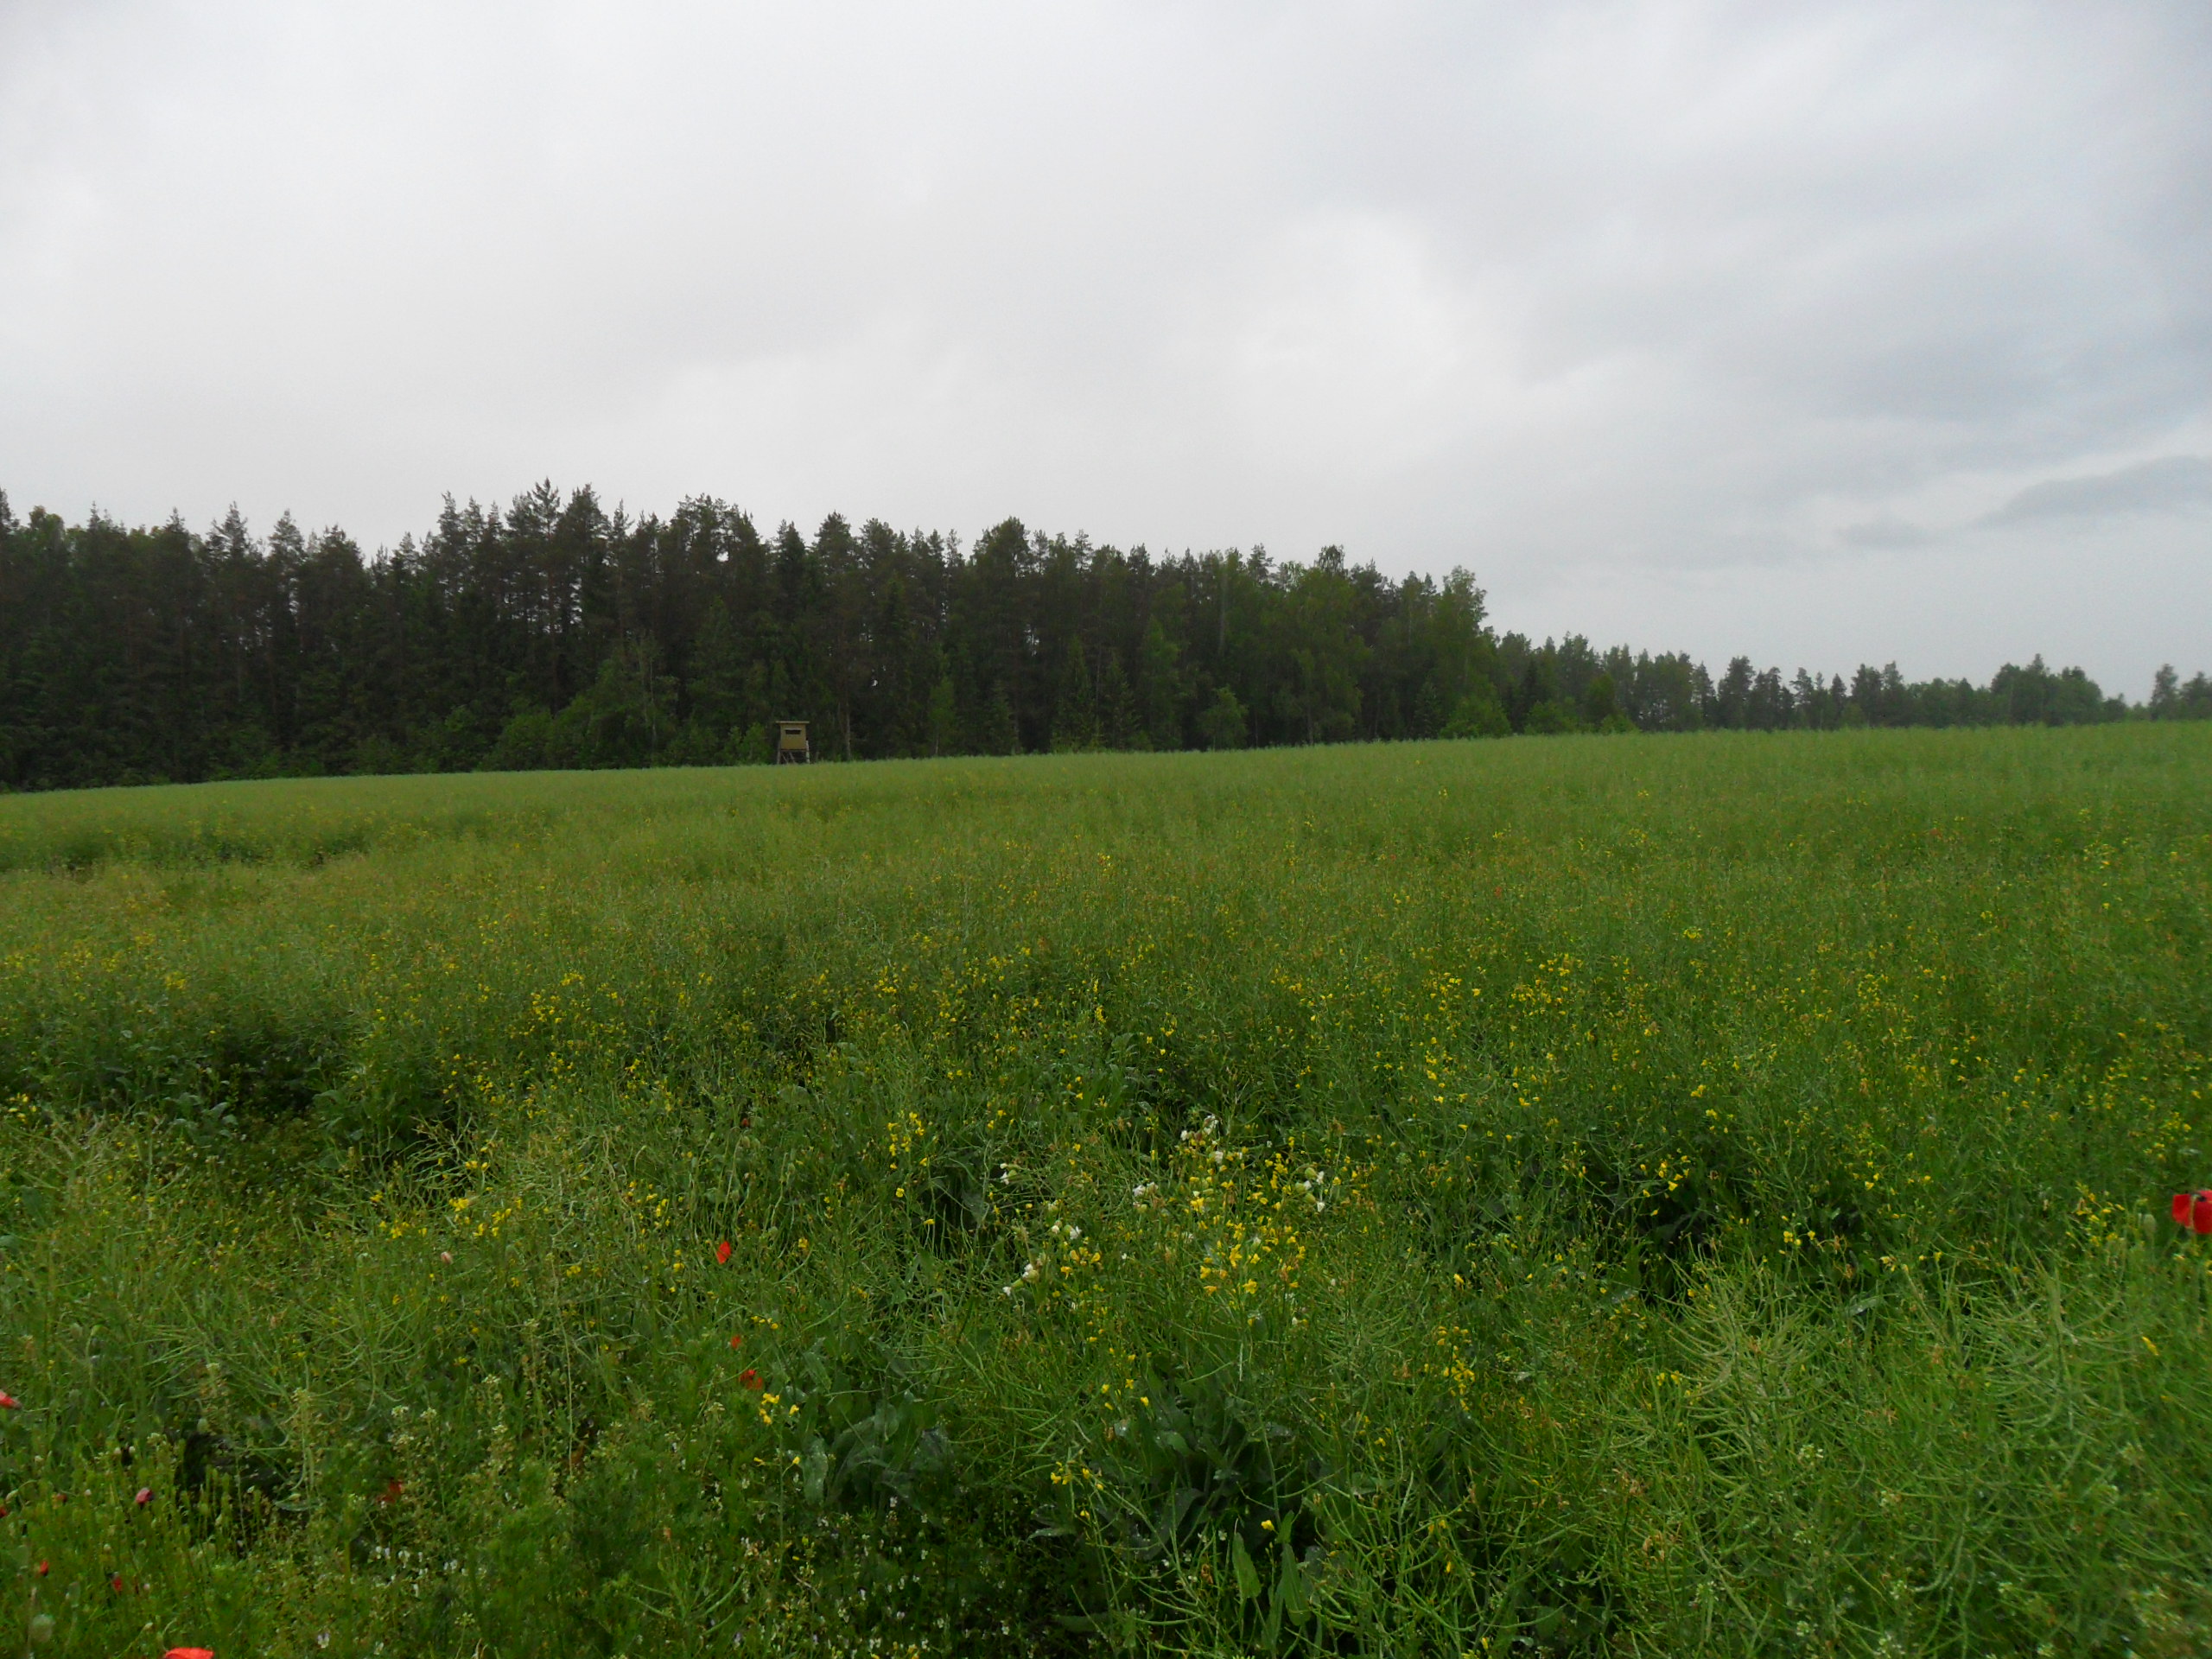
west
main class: Cropland
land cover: Rape and turnip rape
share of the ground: > 75 %
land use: Agriculture (excluding fallow land and kitchen gardens)
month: June
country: LV
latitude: 57.3723
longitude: 22.1709
